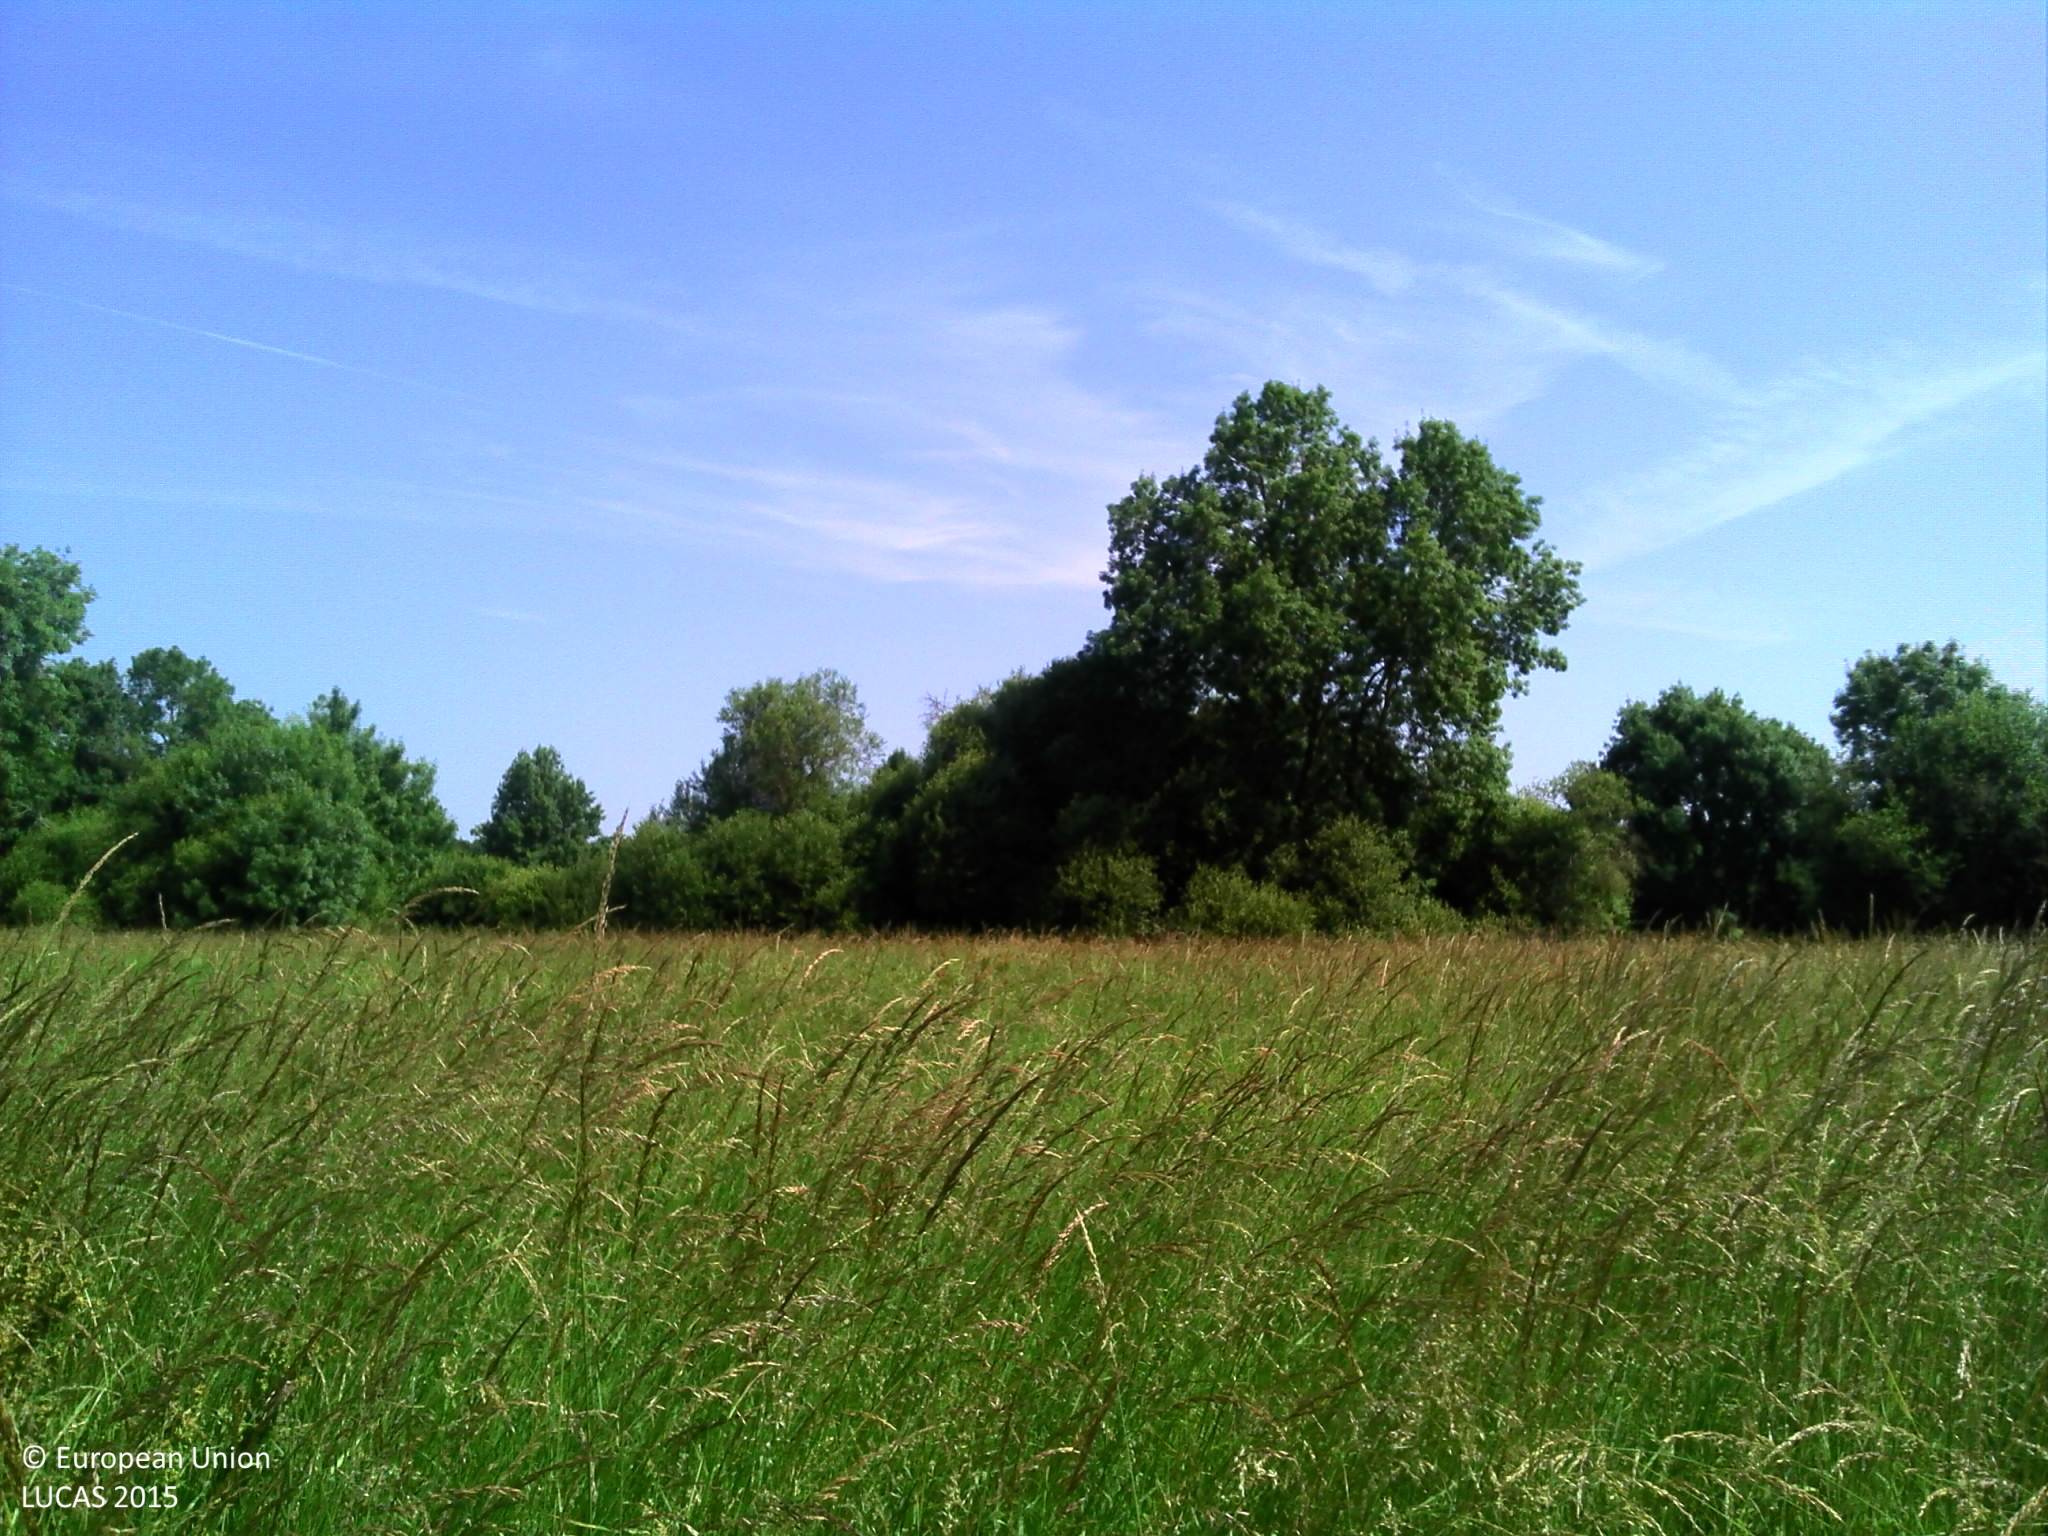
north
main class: Grassland
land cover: Grassland without tree/shrub cover
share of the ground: > 75 %
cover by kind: herbaceous plants 100 %
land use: Agriculture (excluding fallow land and kitchen gardens)
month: June
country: FR
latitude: 47.6994
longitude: 0.0461
